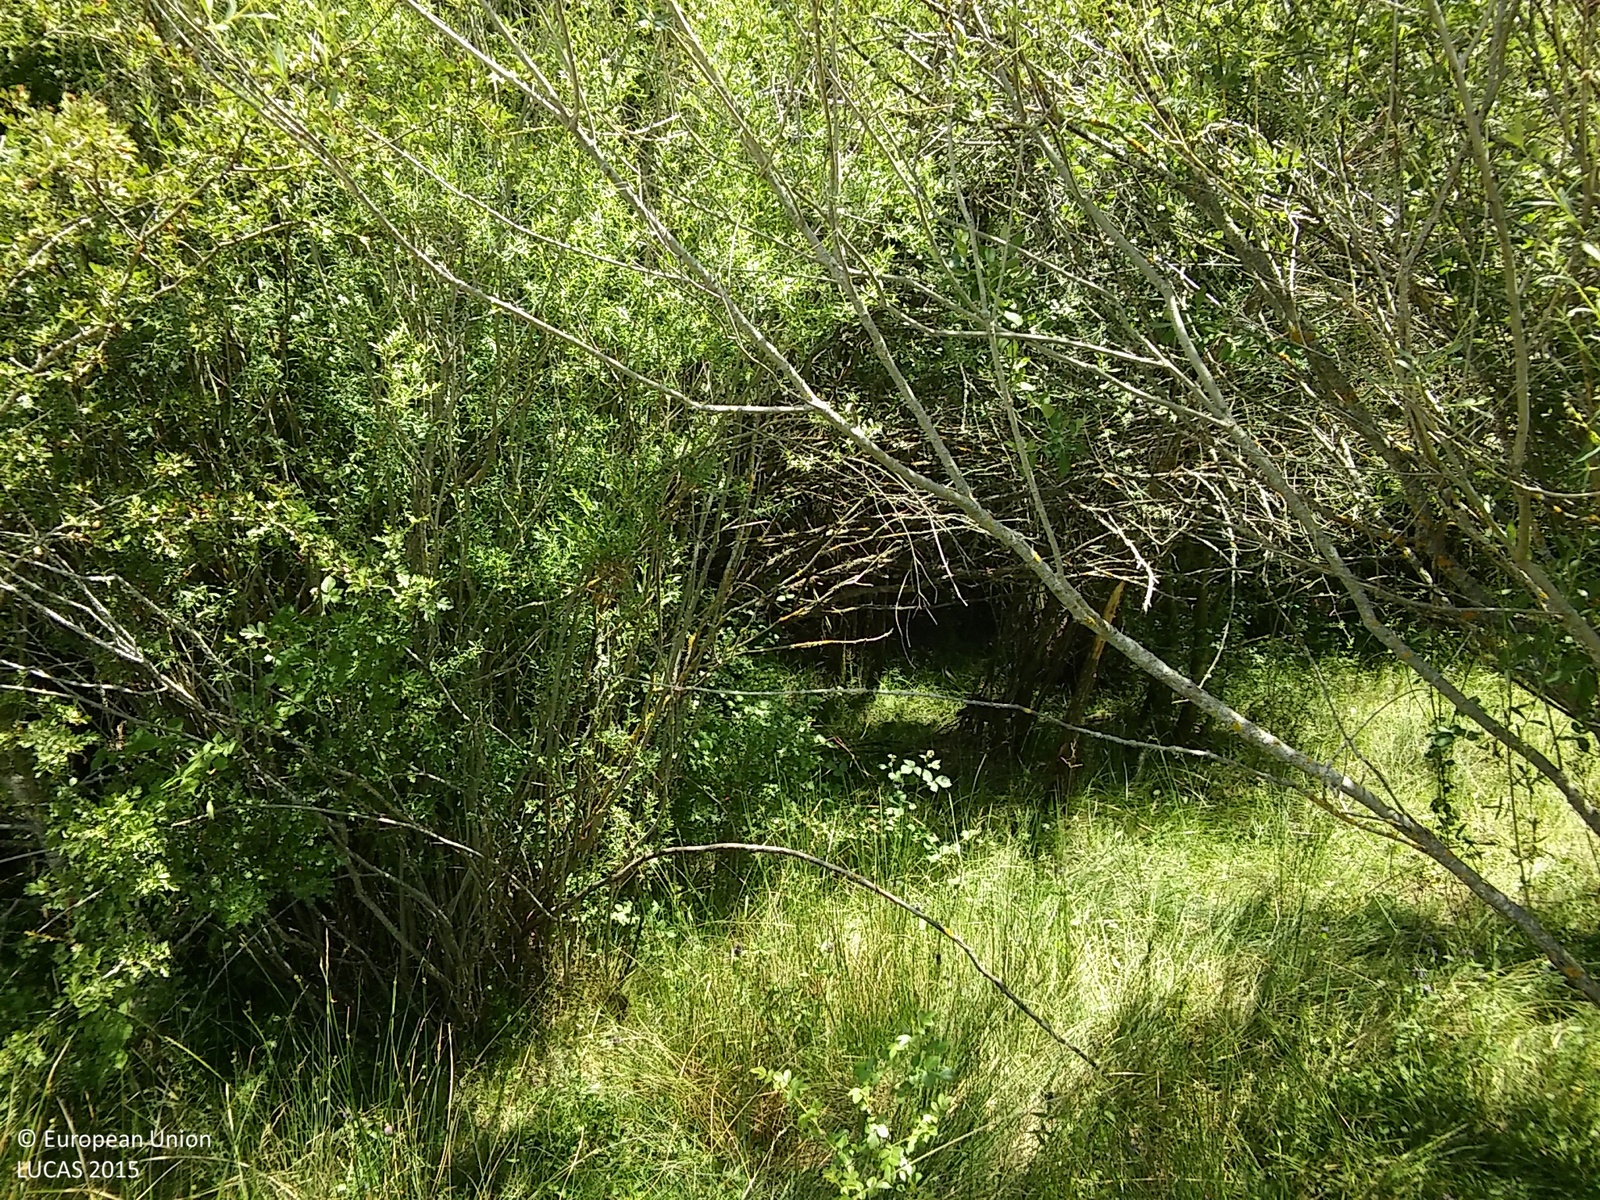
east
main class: Woodland
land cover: Broadleaved woodland
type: floodplain forest
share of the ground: 50 - 75 %
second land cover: Grassland without tree/shrub cover
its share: 25 - 50 %
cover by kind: broadleaved forest trees 60 %, herbaceous plants 35 %, shrubs 5 %
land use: Forestry
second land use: Agriculture (excluding fallow land and kitchen gardens)
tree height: > 5 m
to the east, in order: Broadleaved woodland; Grassland without tree/shrub cover; Inland fresh running water; Broadleaved woodland; Grassland without tree/shrub cover
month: June
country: ES
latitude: 41.3008
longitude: -3.6751
